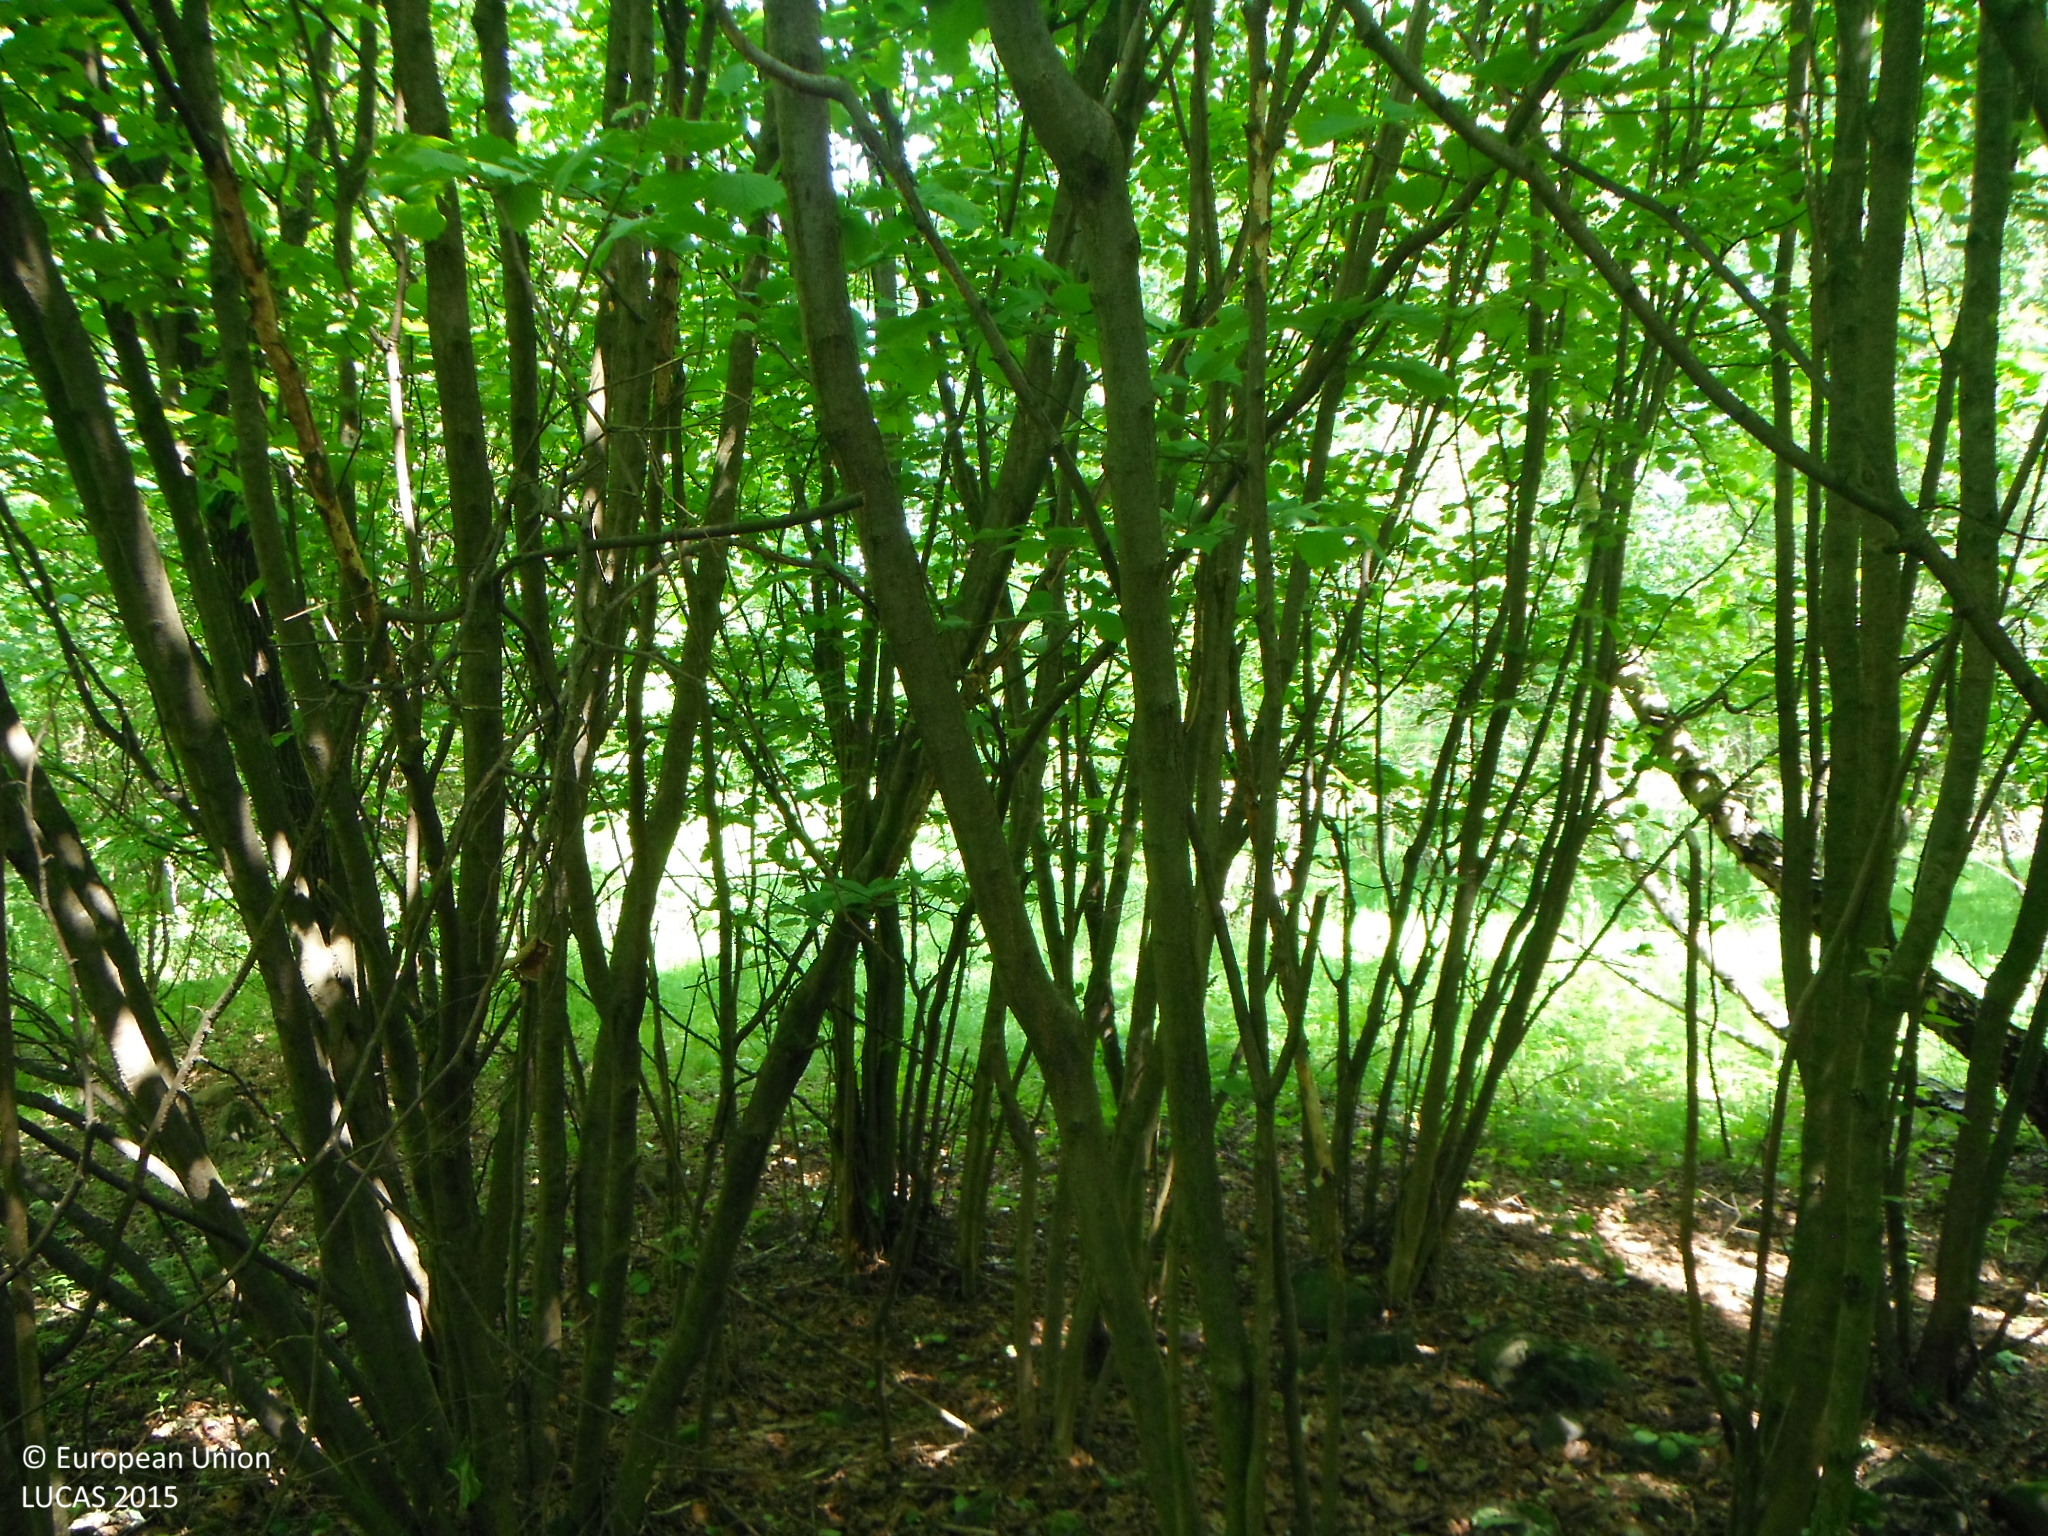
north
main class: Woodland
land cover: Broadleaved woodland
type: acidophilous oak and oak-birch forest
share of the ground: > 75 %
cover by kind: broadleaved forest trees 100 %
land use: Forestry
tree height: > 5 m
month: May
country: SK
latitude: 48.4334
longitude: 19.0086
